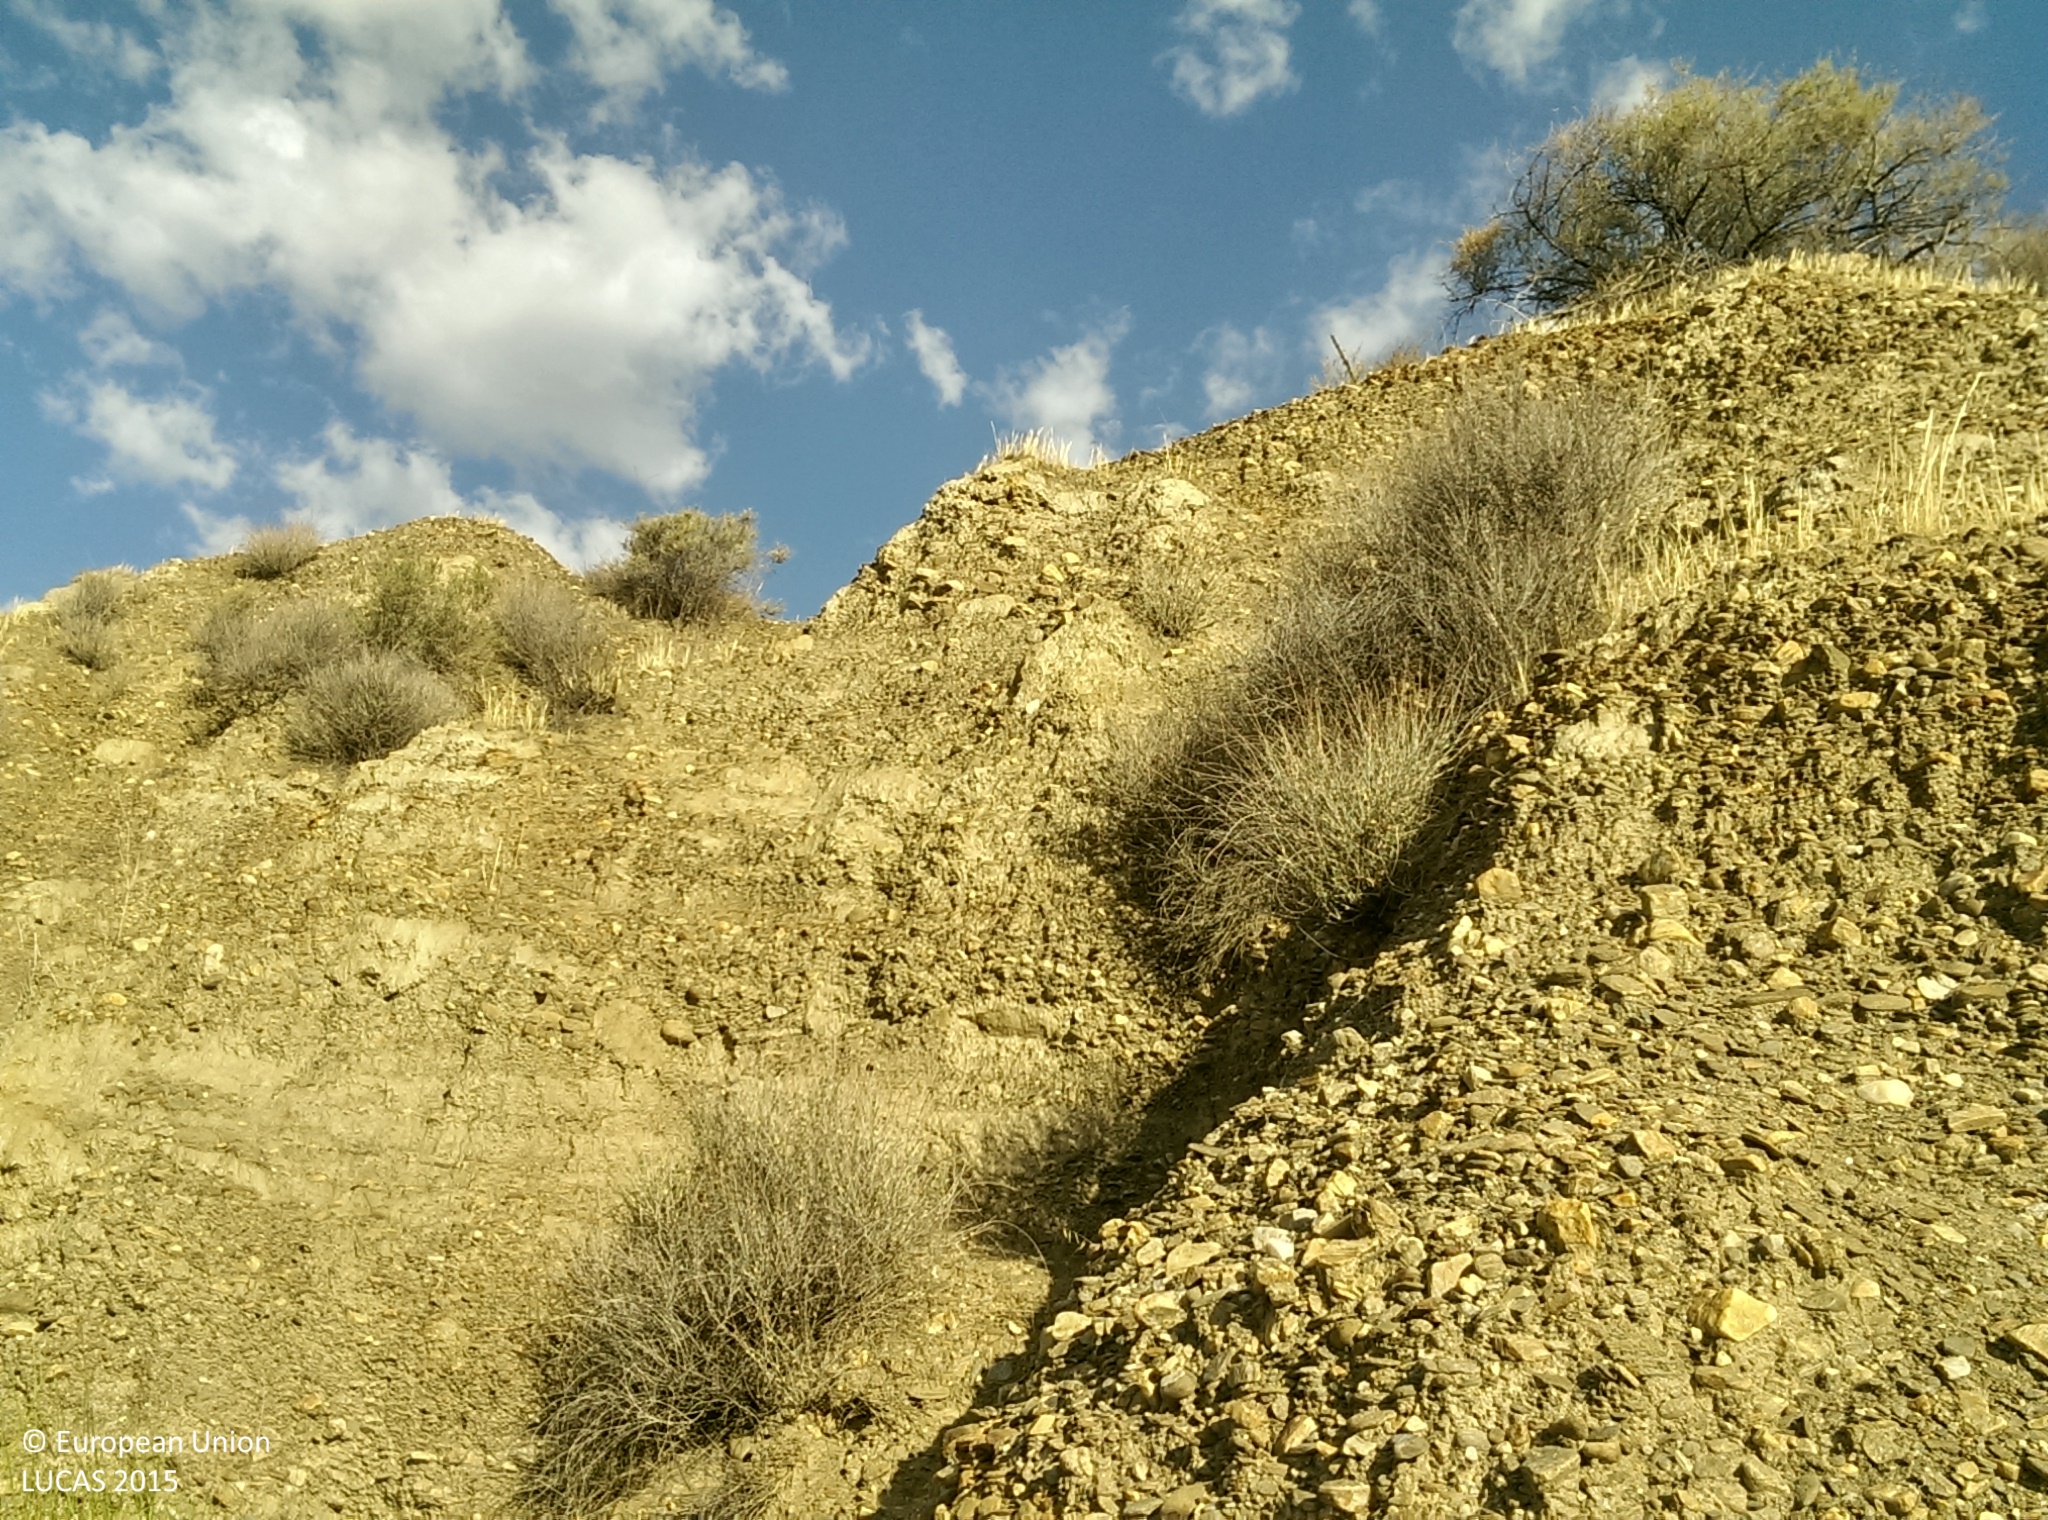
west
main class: Woodland
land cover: Pine dominated coniferous woodland
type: coniferous forest of the mediterranean region
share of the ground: 25 - 50 %
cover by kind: unconsolidated bare surface 40 %, coniferous forest trees 25 %, herbaceous plants 20 %, shrubs 15 %
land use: Forestry
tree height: > 5 m
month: July
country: ES
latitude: 37.3213
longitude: -3.1796
